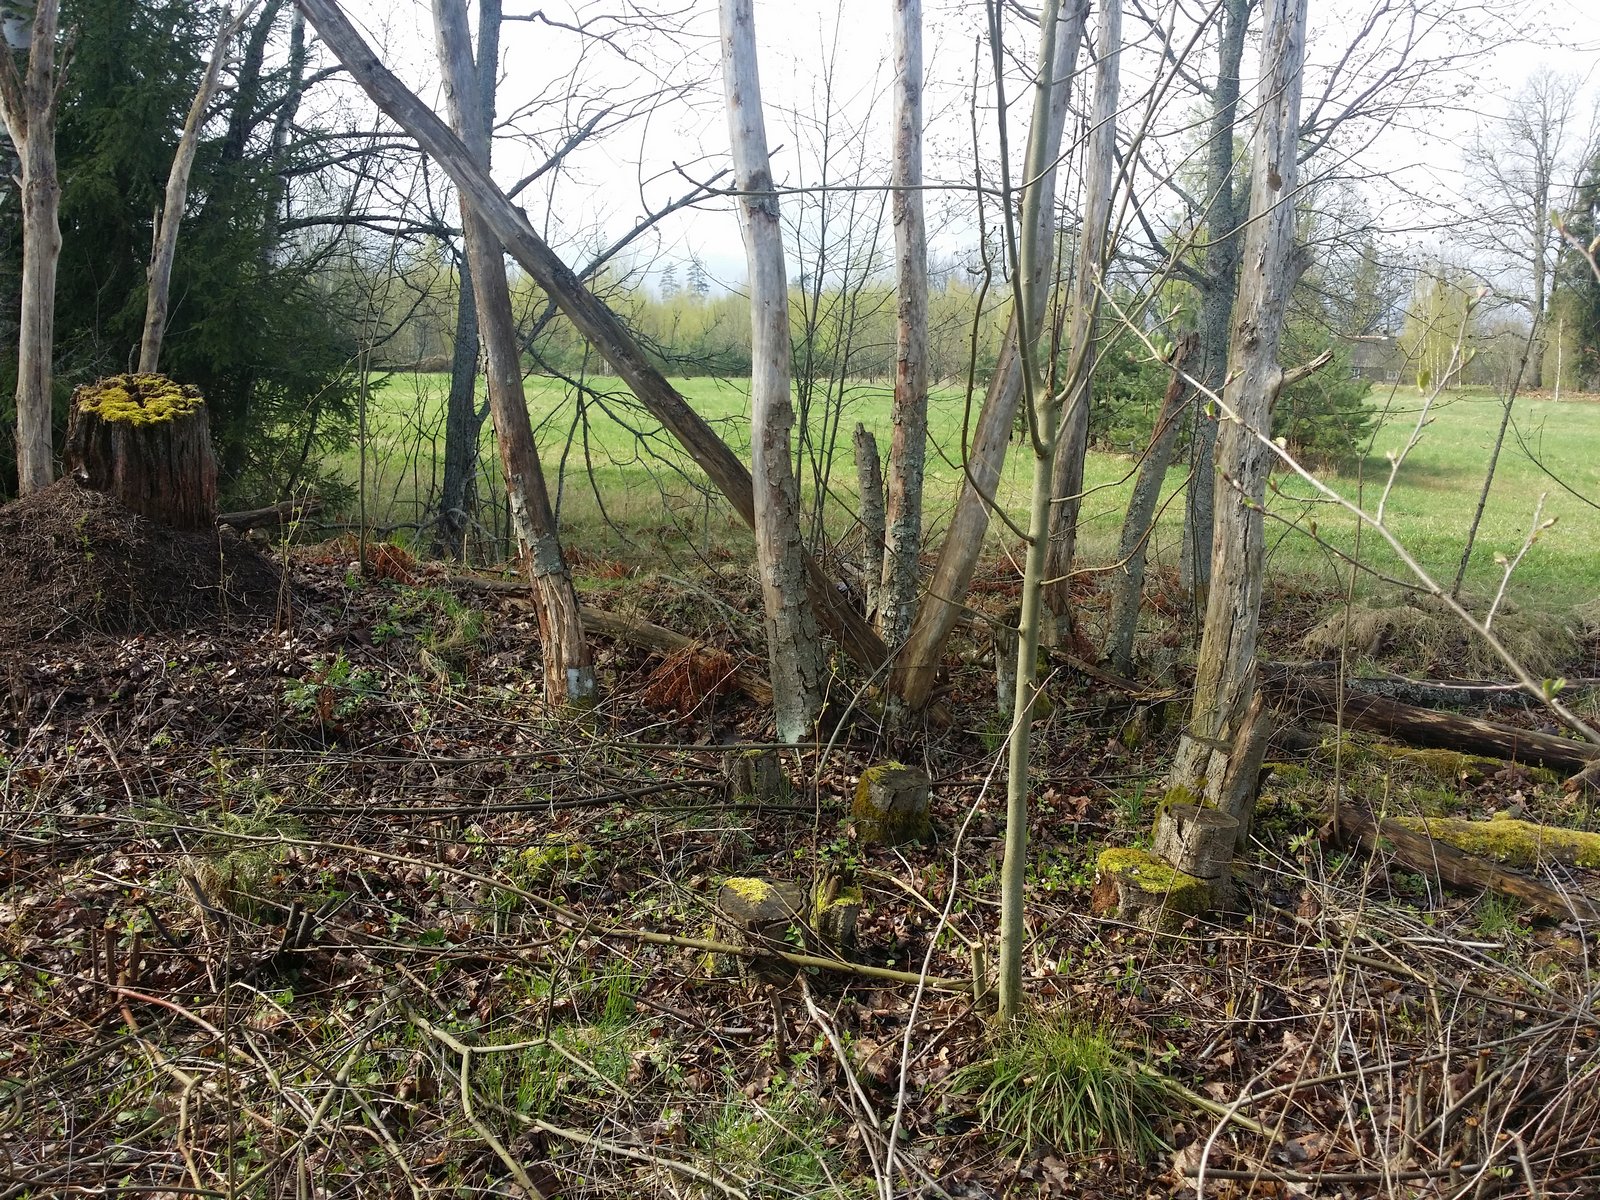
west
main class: Woodland
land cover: Broadleaved woodland
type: non-riverine alder, birch or aspen forest
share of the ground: 50 - 75 %
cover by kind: broadleaved forest trees 70 %, herbaceous plants 30 %
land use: Forestry
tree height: < 5 m
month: May
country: LV
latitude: 57.3999
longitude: 25.9881
